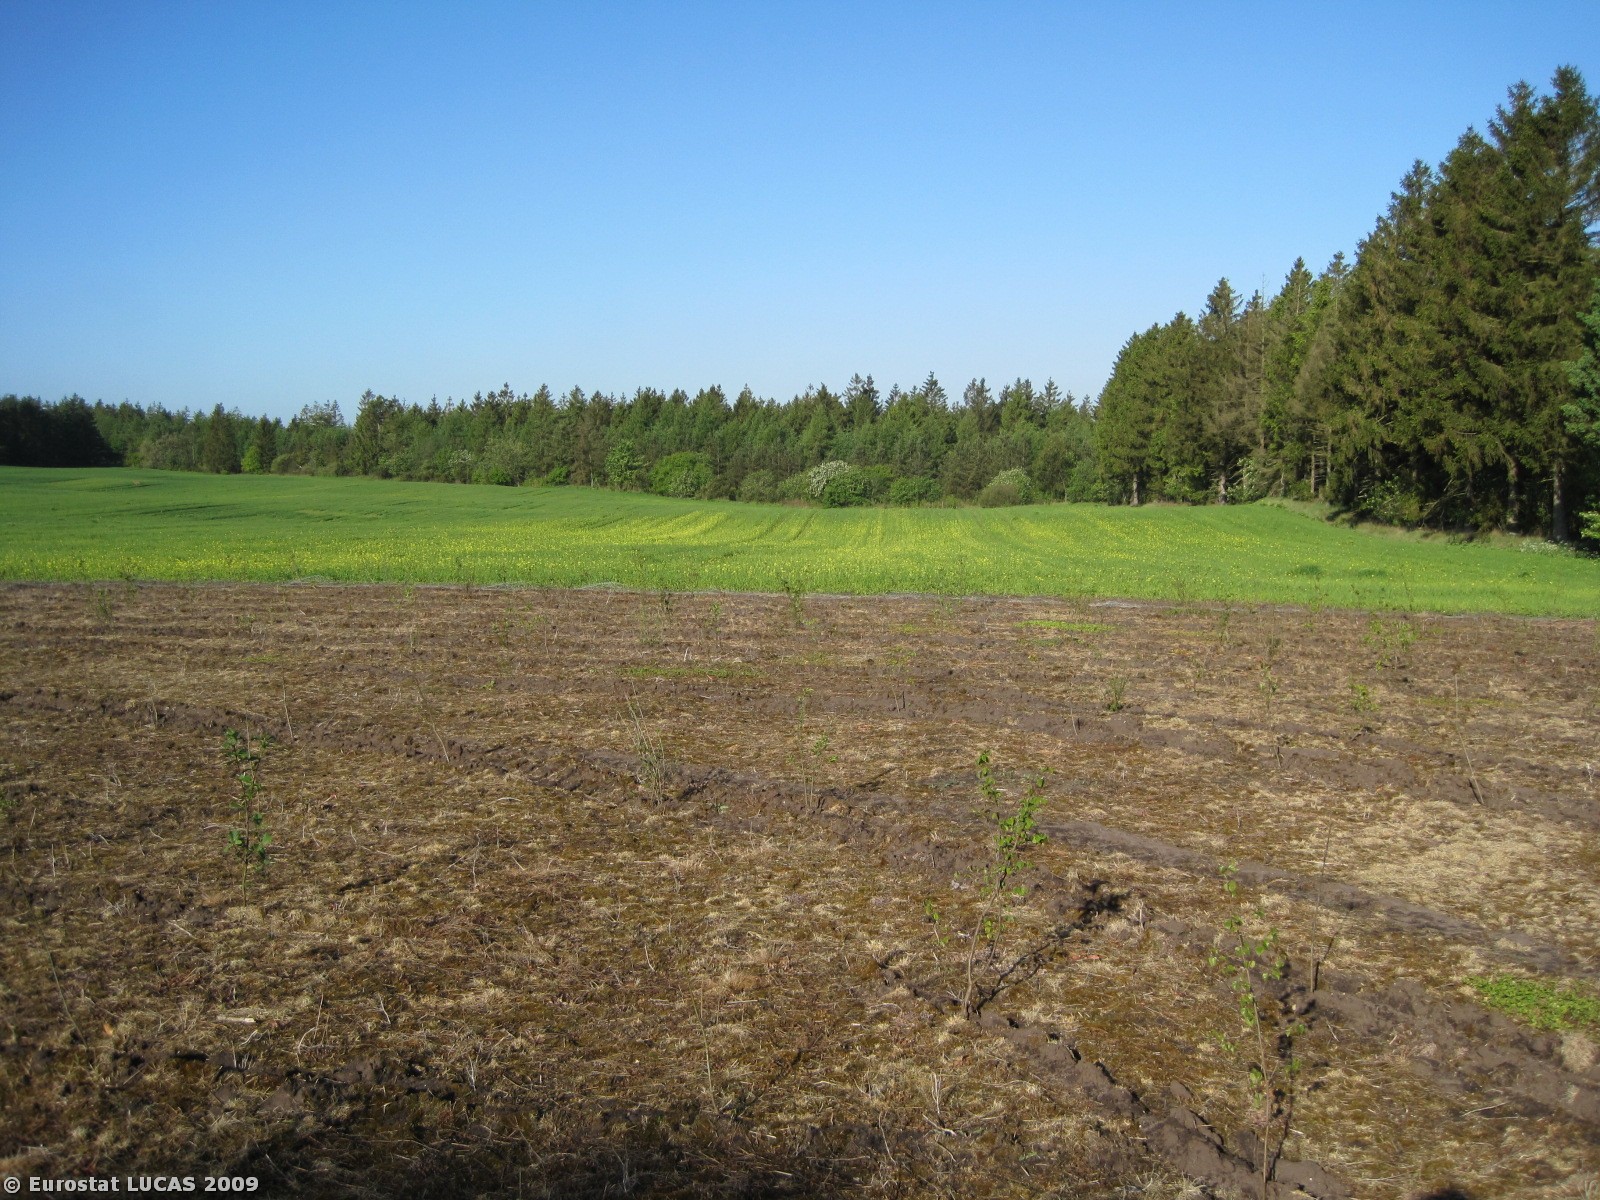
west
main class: Woodland
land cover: Broadleaved woodland
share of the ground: < 10 %
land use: Agriculture (excluding fallow land and kitchen gardens)
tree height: < 5 m
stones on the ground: < 10 %
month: May
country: DK
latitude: 56.4012
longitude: 9.2394
